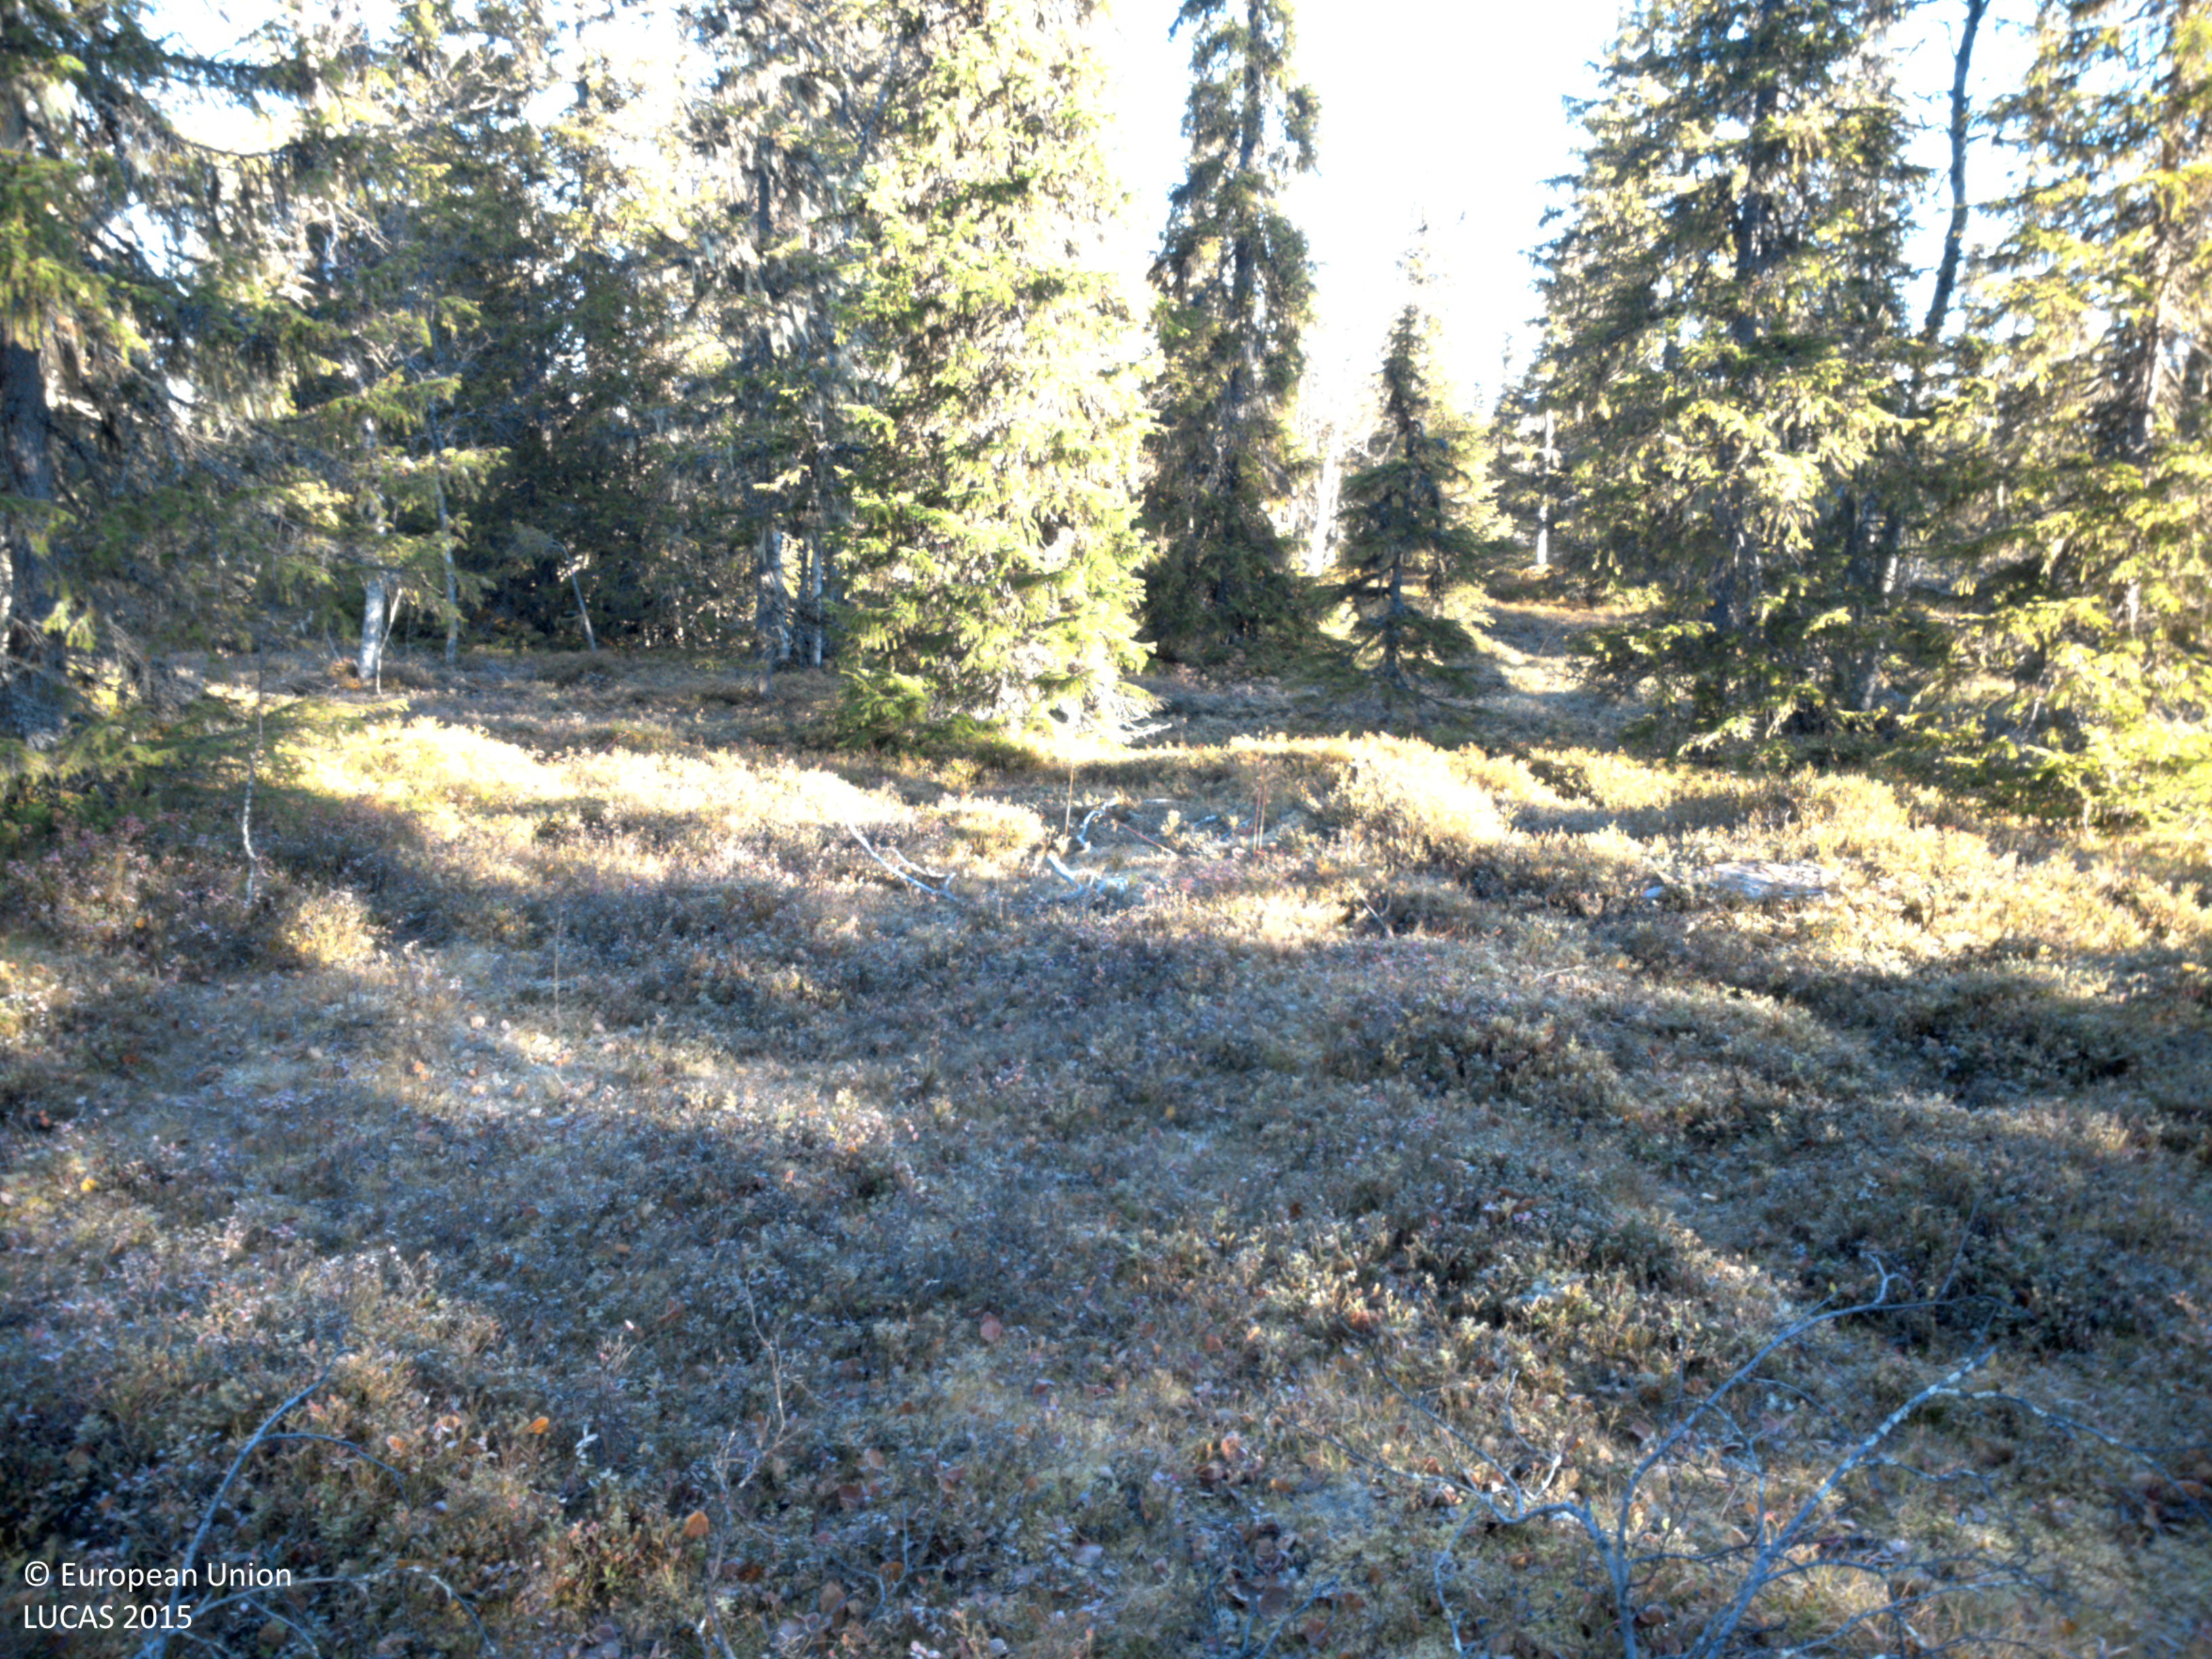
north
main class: Woodland
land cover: Spruce dominated mixed woodland
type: boreal forest
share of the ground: 25 - 50 %
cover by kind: coniferous forest trees 35 %, shrubs 30 %, broadleaved forest trees 15 %, lichens and mosses 15 %, herbaceous plants 5 %
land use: Forestry
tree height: > 5 m
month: October
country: SE
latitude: 64.5518
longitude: 17.7887
